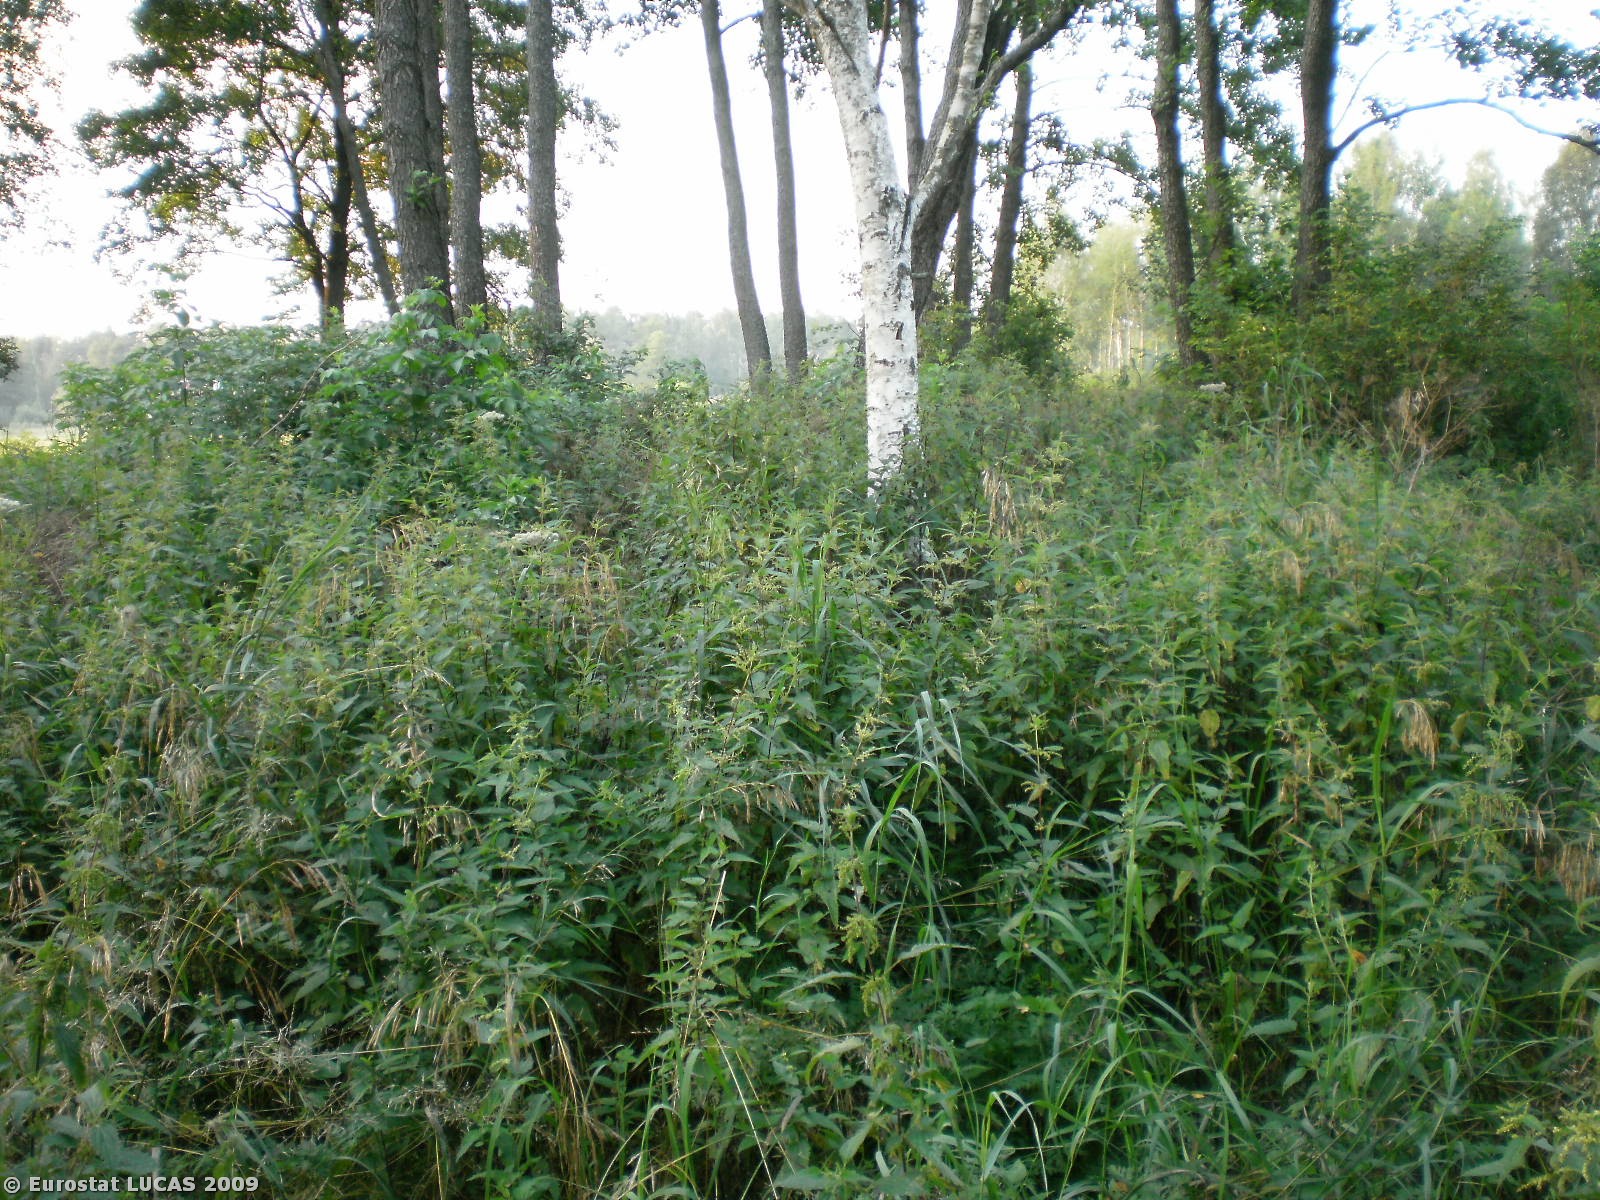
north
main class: Woodland
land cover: Broadleaved woodland
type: mesophytic deciduous forest
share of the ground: 25 - 50 %
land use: Unused
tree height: > 5 m
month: July
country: PL
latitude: 53.4420
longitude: 21.0187
